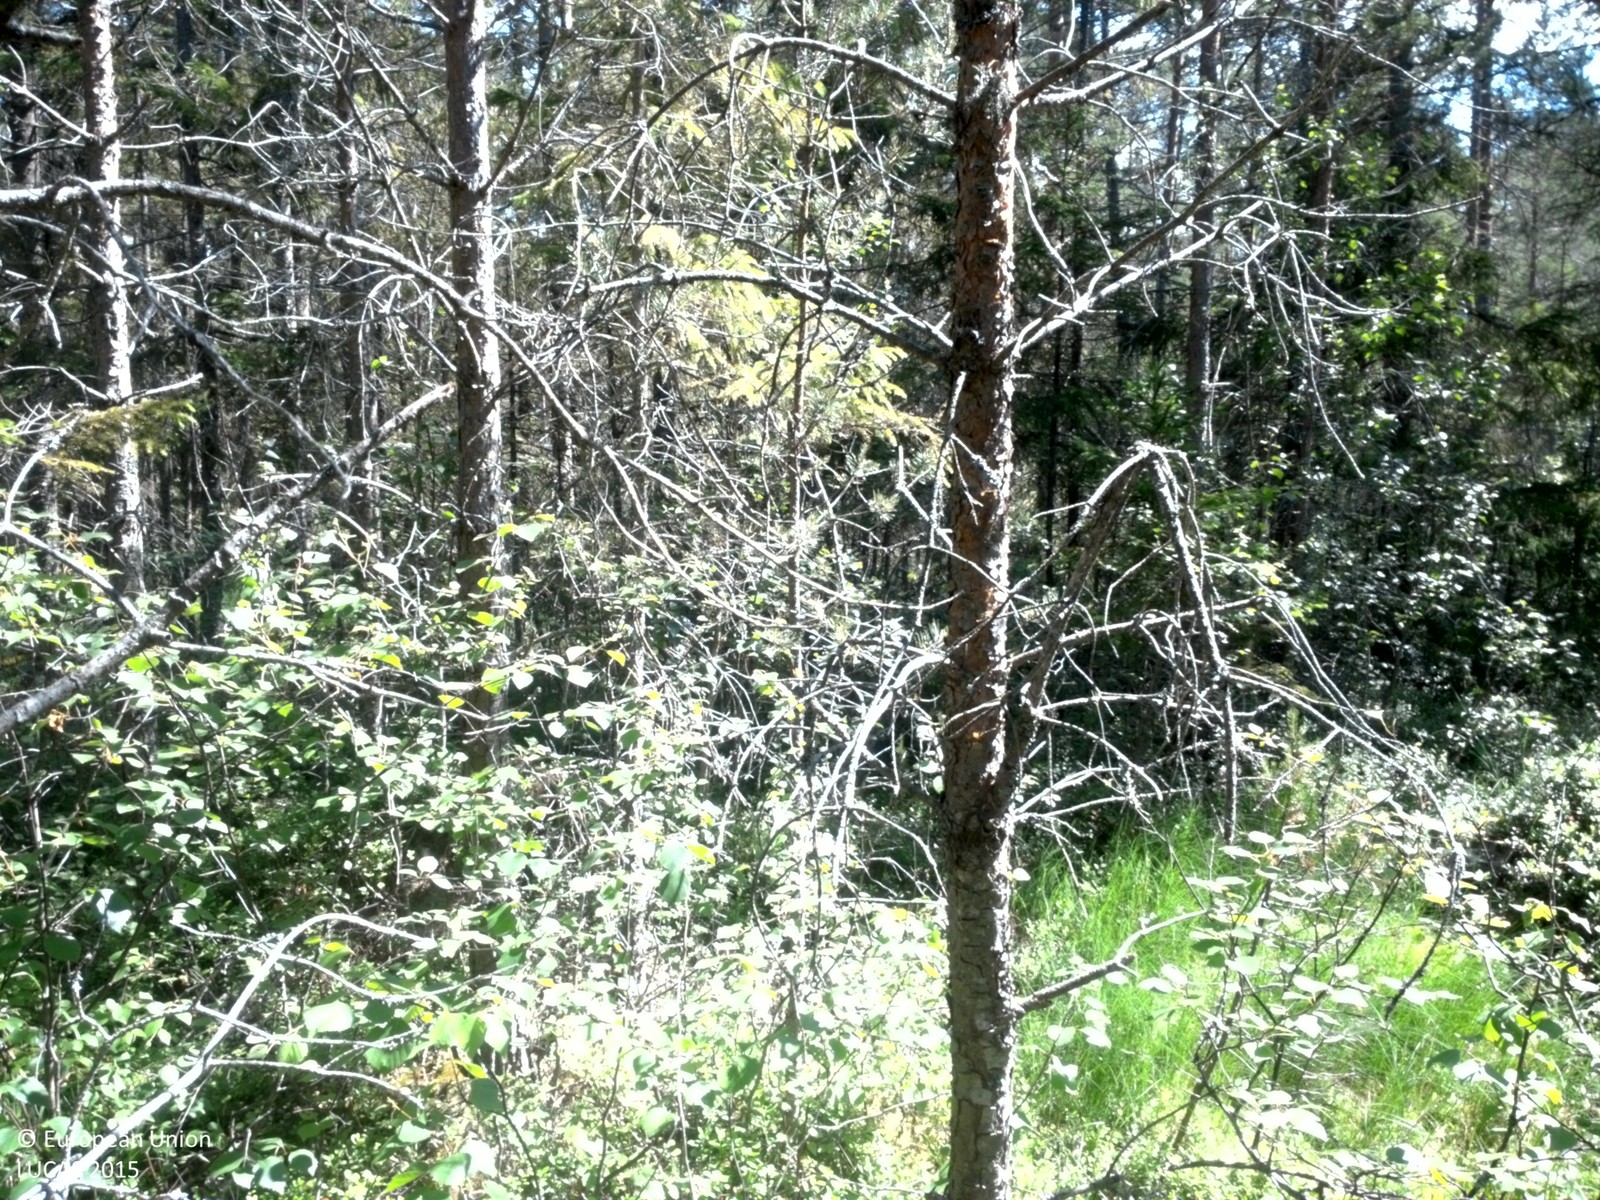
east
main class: Woodland
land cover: Other coniferous woodland
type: boreal forest
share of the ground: 50 - 75 %
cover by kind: coniferous forest trees 60 %, broadleaved forest trees 10 %, shrubs 10 %, herbaceous plants 10 %, lichens and mosses 10 %
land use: Forestry
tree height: > 5 m
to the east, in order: Other coniferous woodland; Ditches and canals; Other coniferous woodland; Pine dominated coniferous woodland; Other coniferous woodland; Spruce dominated coniferous woodland; Spruce dominated mixed woodland; Ditches and canals; Other mixed woodland; Pine dominated coniferous woodland
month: July
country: SE
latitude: 59.6327
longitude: 14.7255
